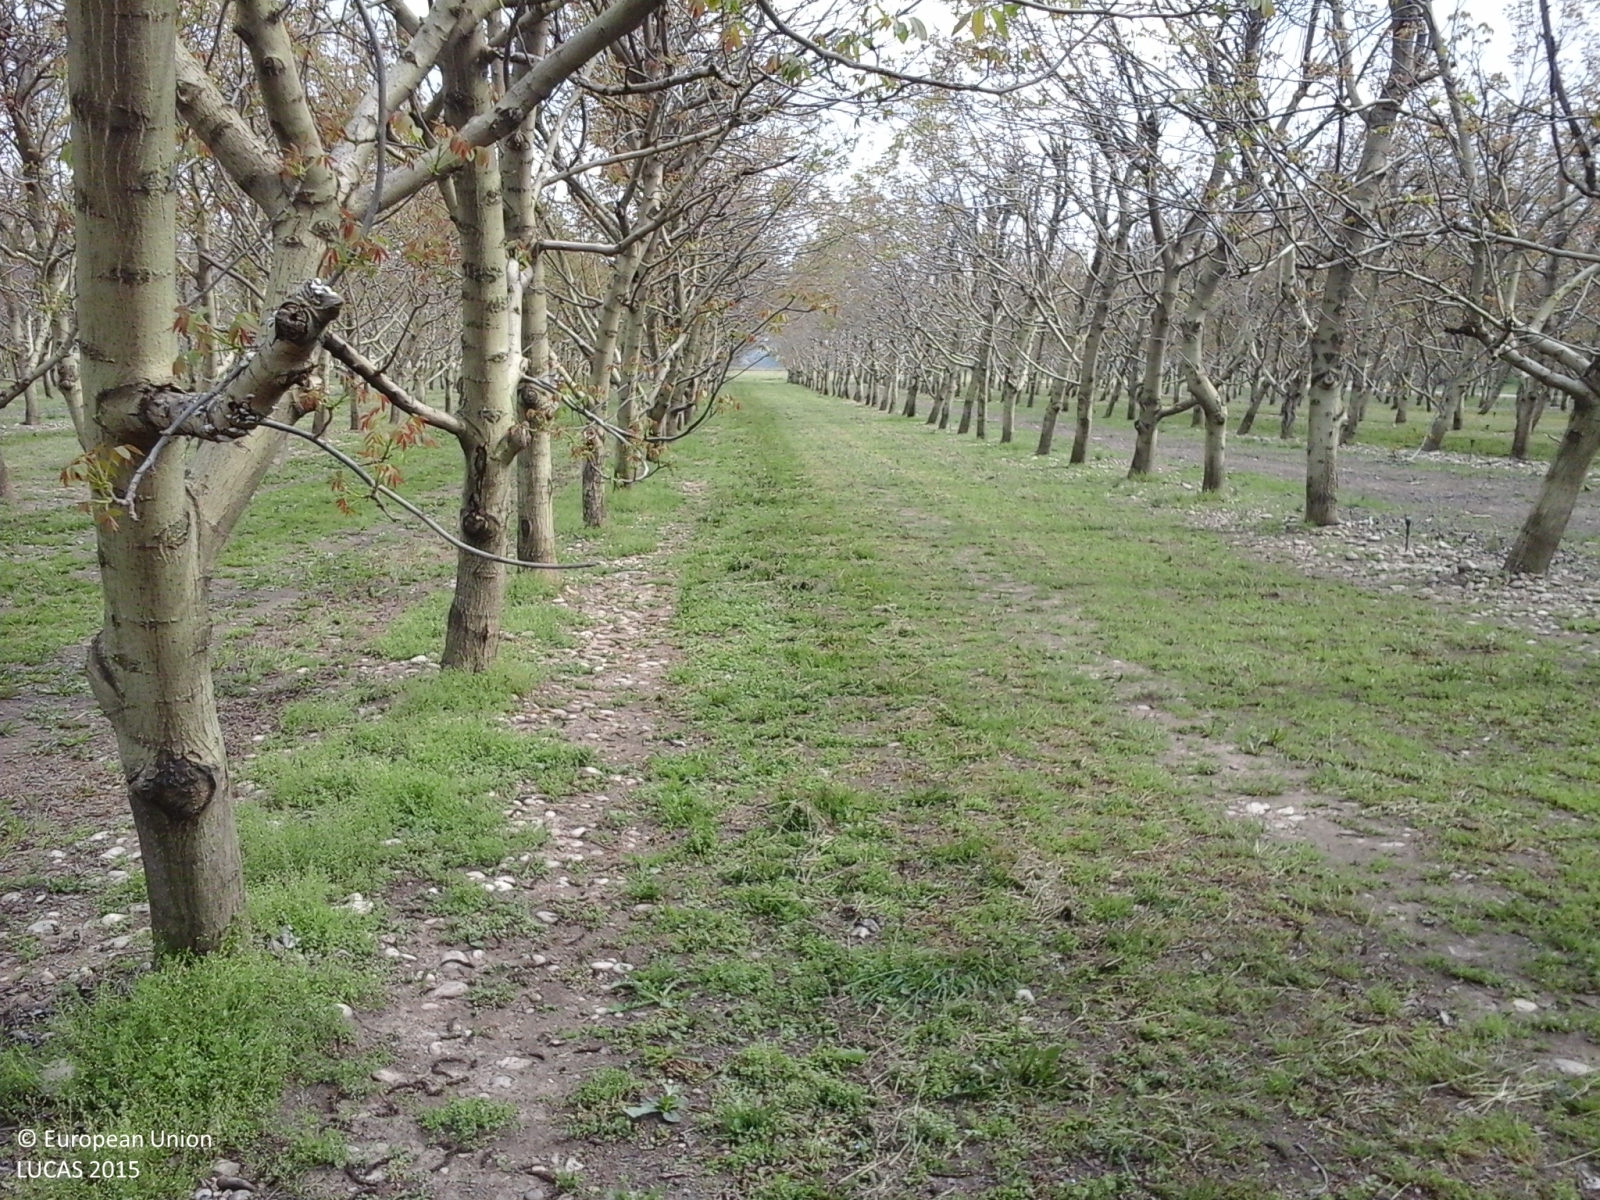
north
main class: Cropland
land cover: Nuts trees
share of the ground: 50 - 75 %
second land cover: Grassland without tree/shrub cover
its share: 50 - 75 %
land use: Agriculture (excluding fallow land and kitchen gardens)
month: May
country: IT
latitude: 44.5973
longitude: 7.7747
